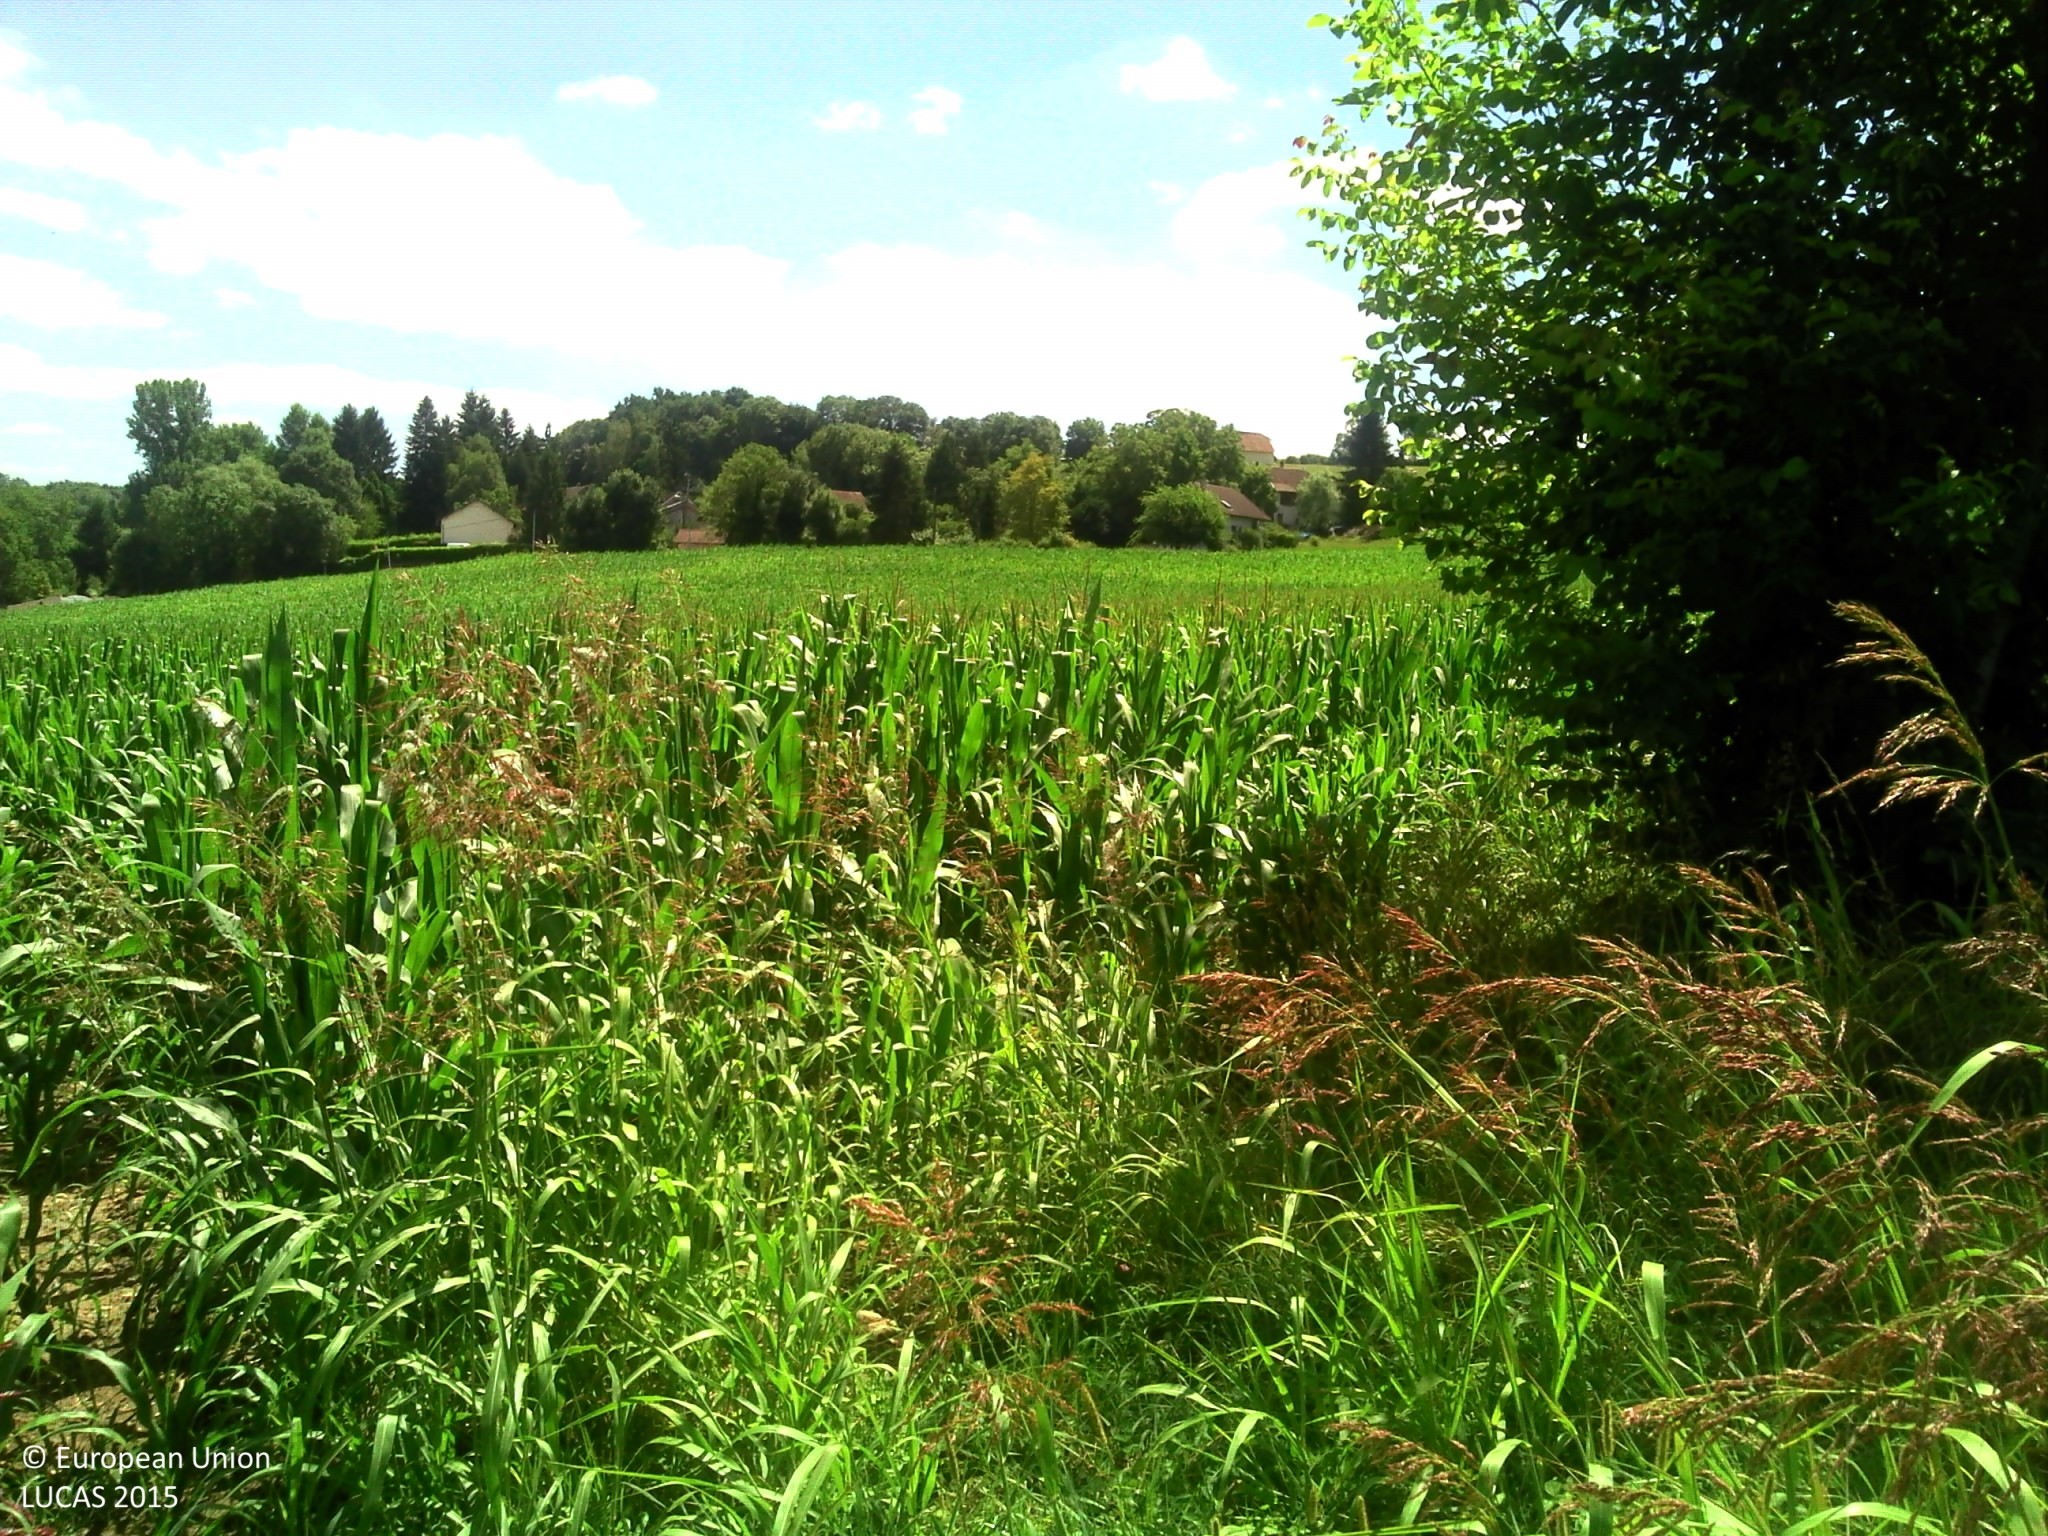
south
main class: Grassland
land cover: Spontaneously vegetated surfaces
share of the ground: > 75 %
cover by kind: herbaceous plants 100 %
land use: Agriculture (excluding fallow land and kitchen gardens)
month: July
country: FR
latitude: 45.6769
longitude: 5.4468
